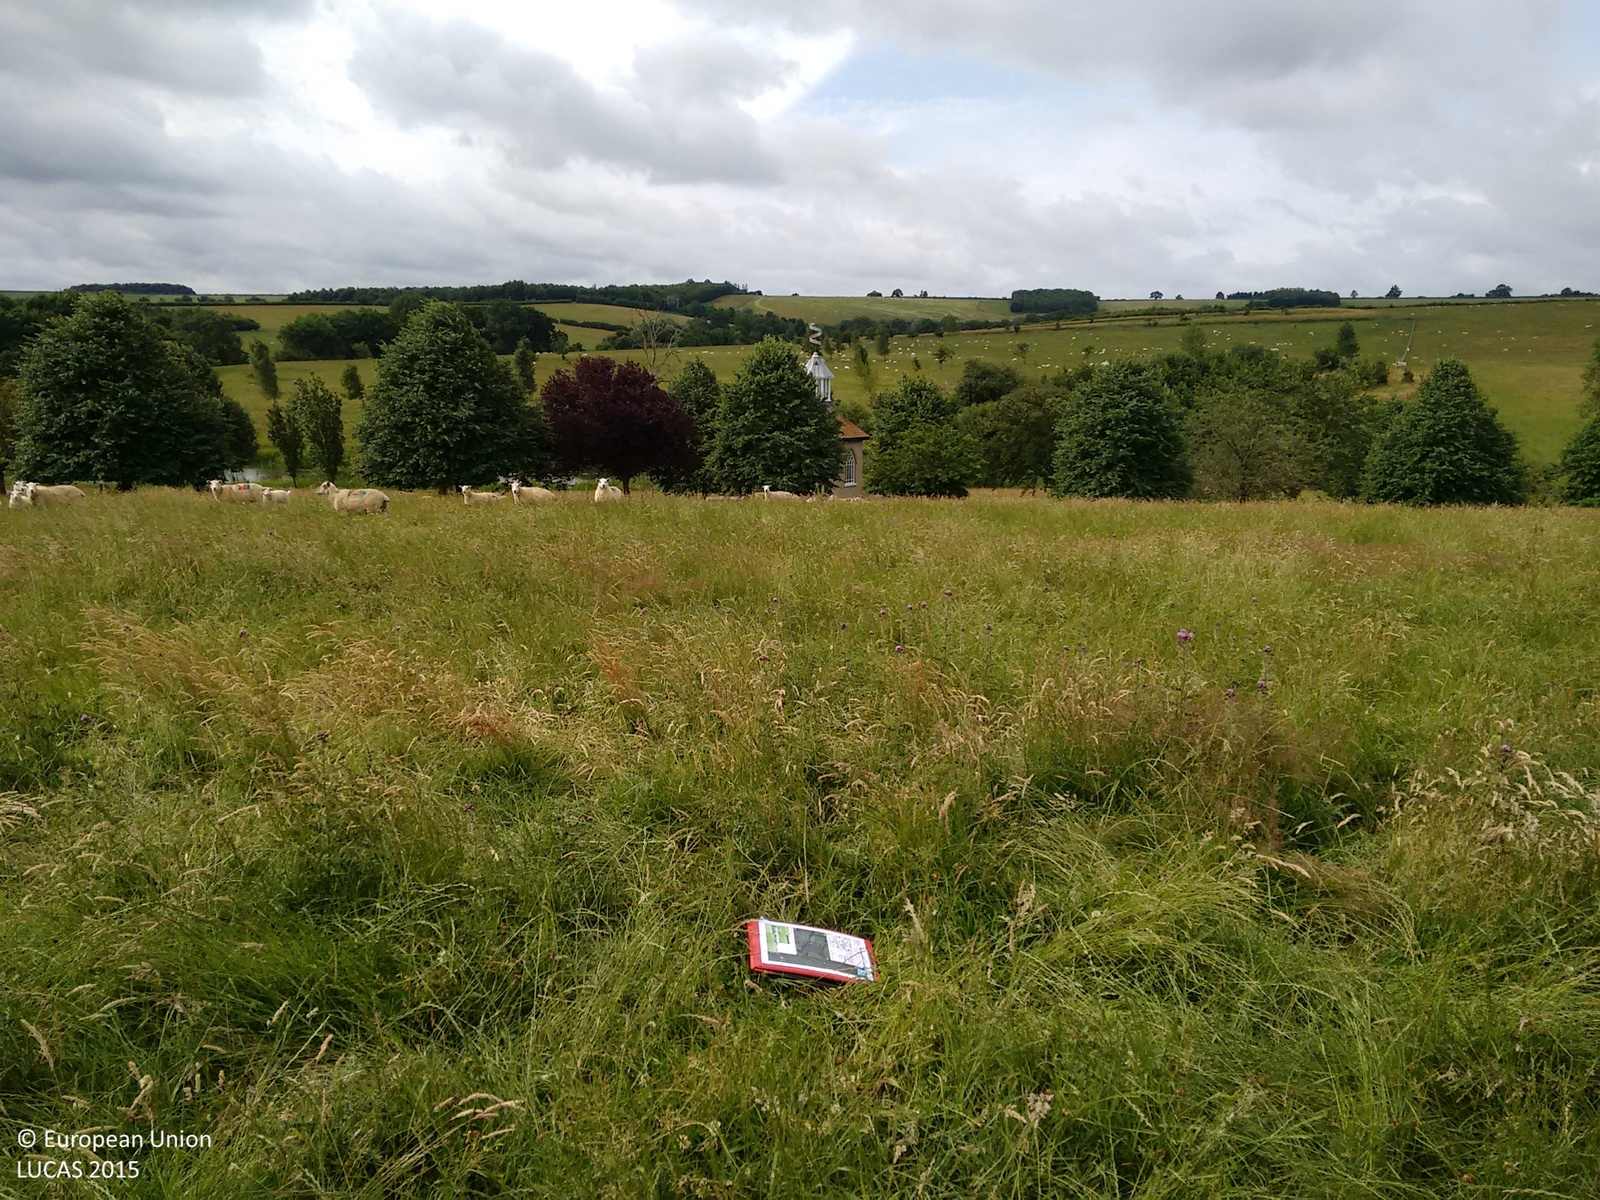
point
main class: Grassland
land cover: Grassland without tree/shrub cover
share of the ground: > 75 %
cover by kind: herbaceous plants 100 %
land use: Agriculture (excluding fallow land and kitchen gardens)
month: July
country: GB
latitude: 52.6287
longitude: -0.7821
